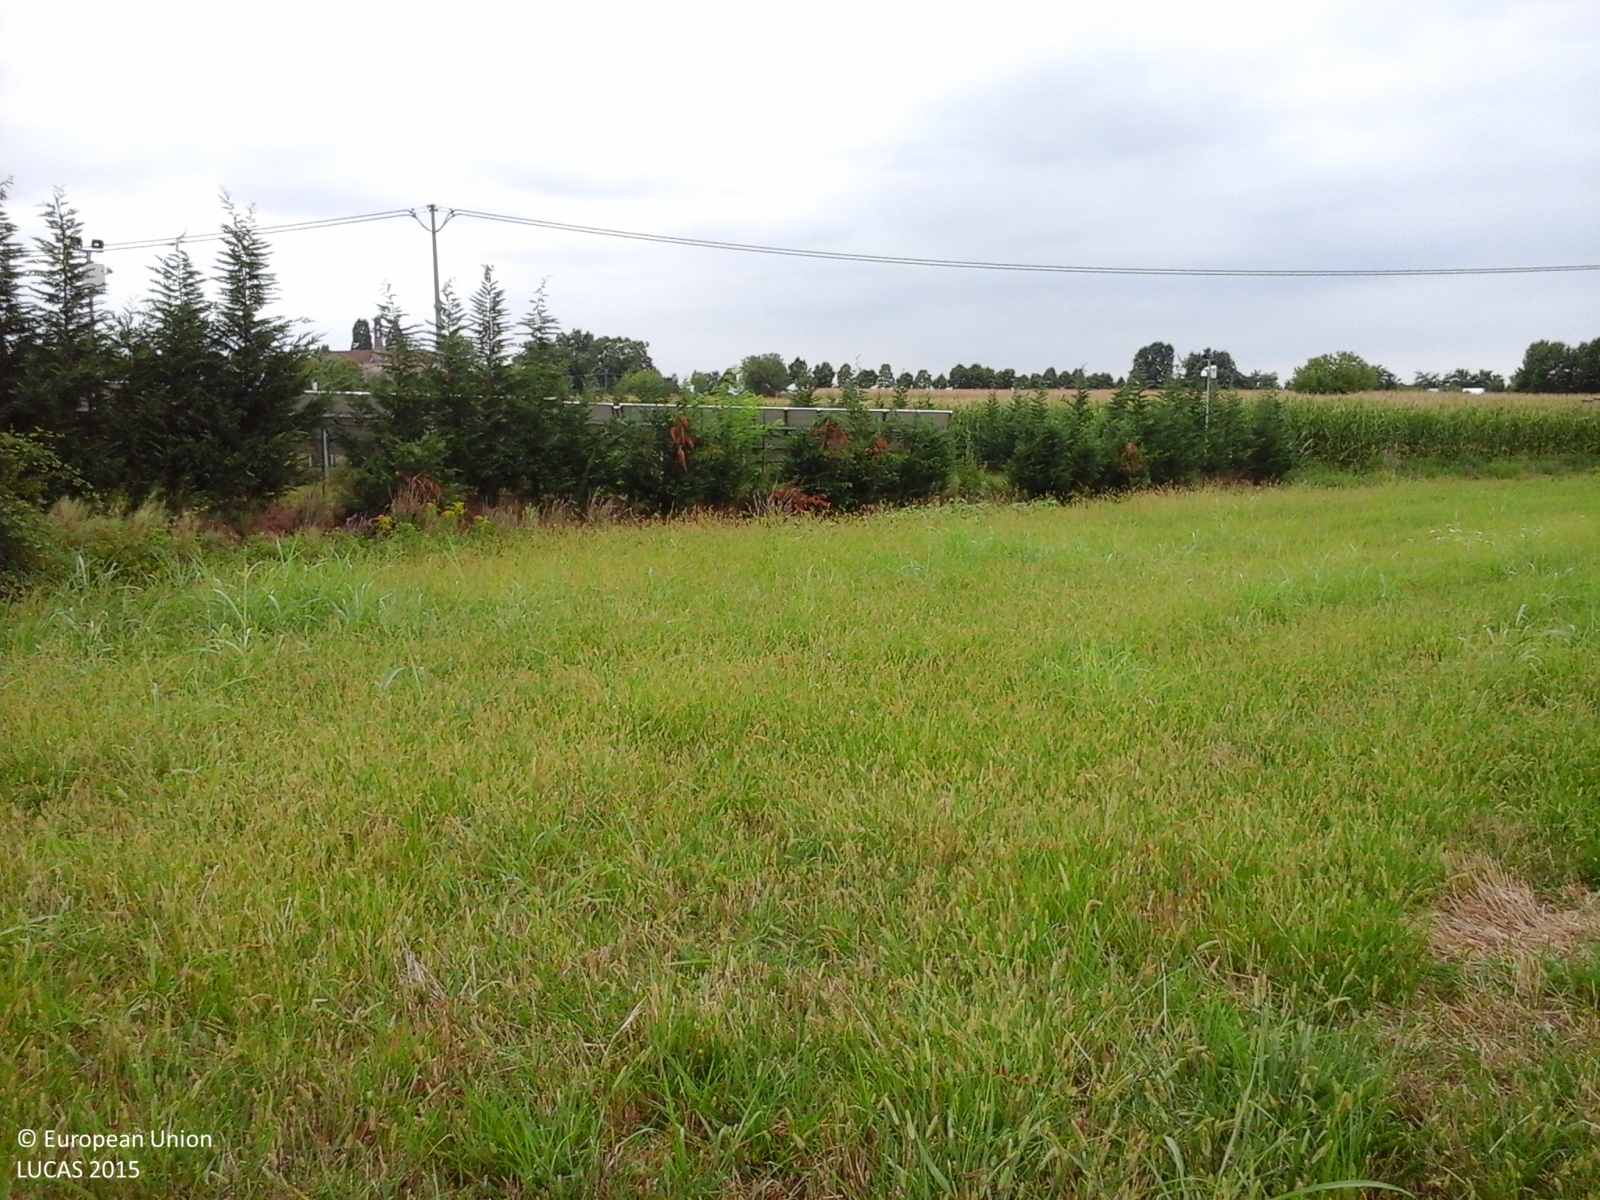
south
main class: Grassland
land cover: Spontaneously vegetated surfaces
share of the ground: > 75 %
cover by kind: herbaceous plants 100 %
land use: Agriculture (excluding fallow land and kitchen gardens)
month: July
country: IT
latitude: 44.7781
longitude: 7.7927
